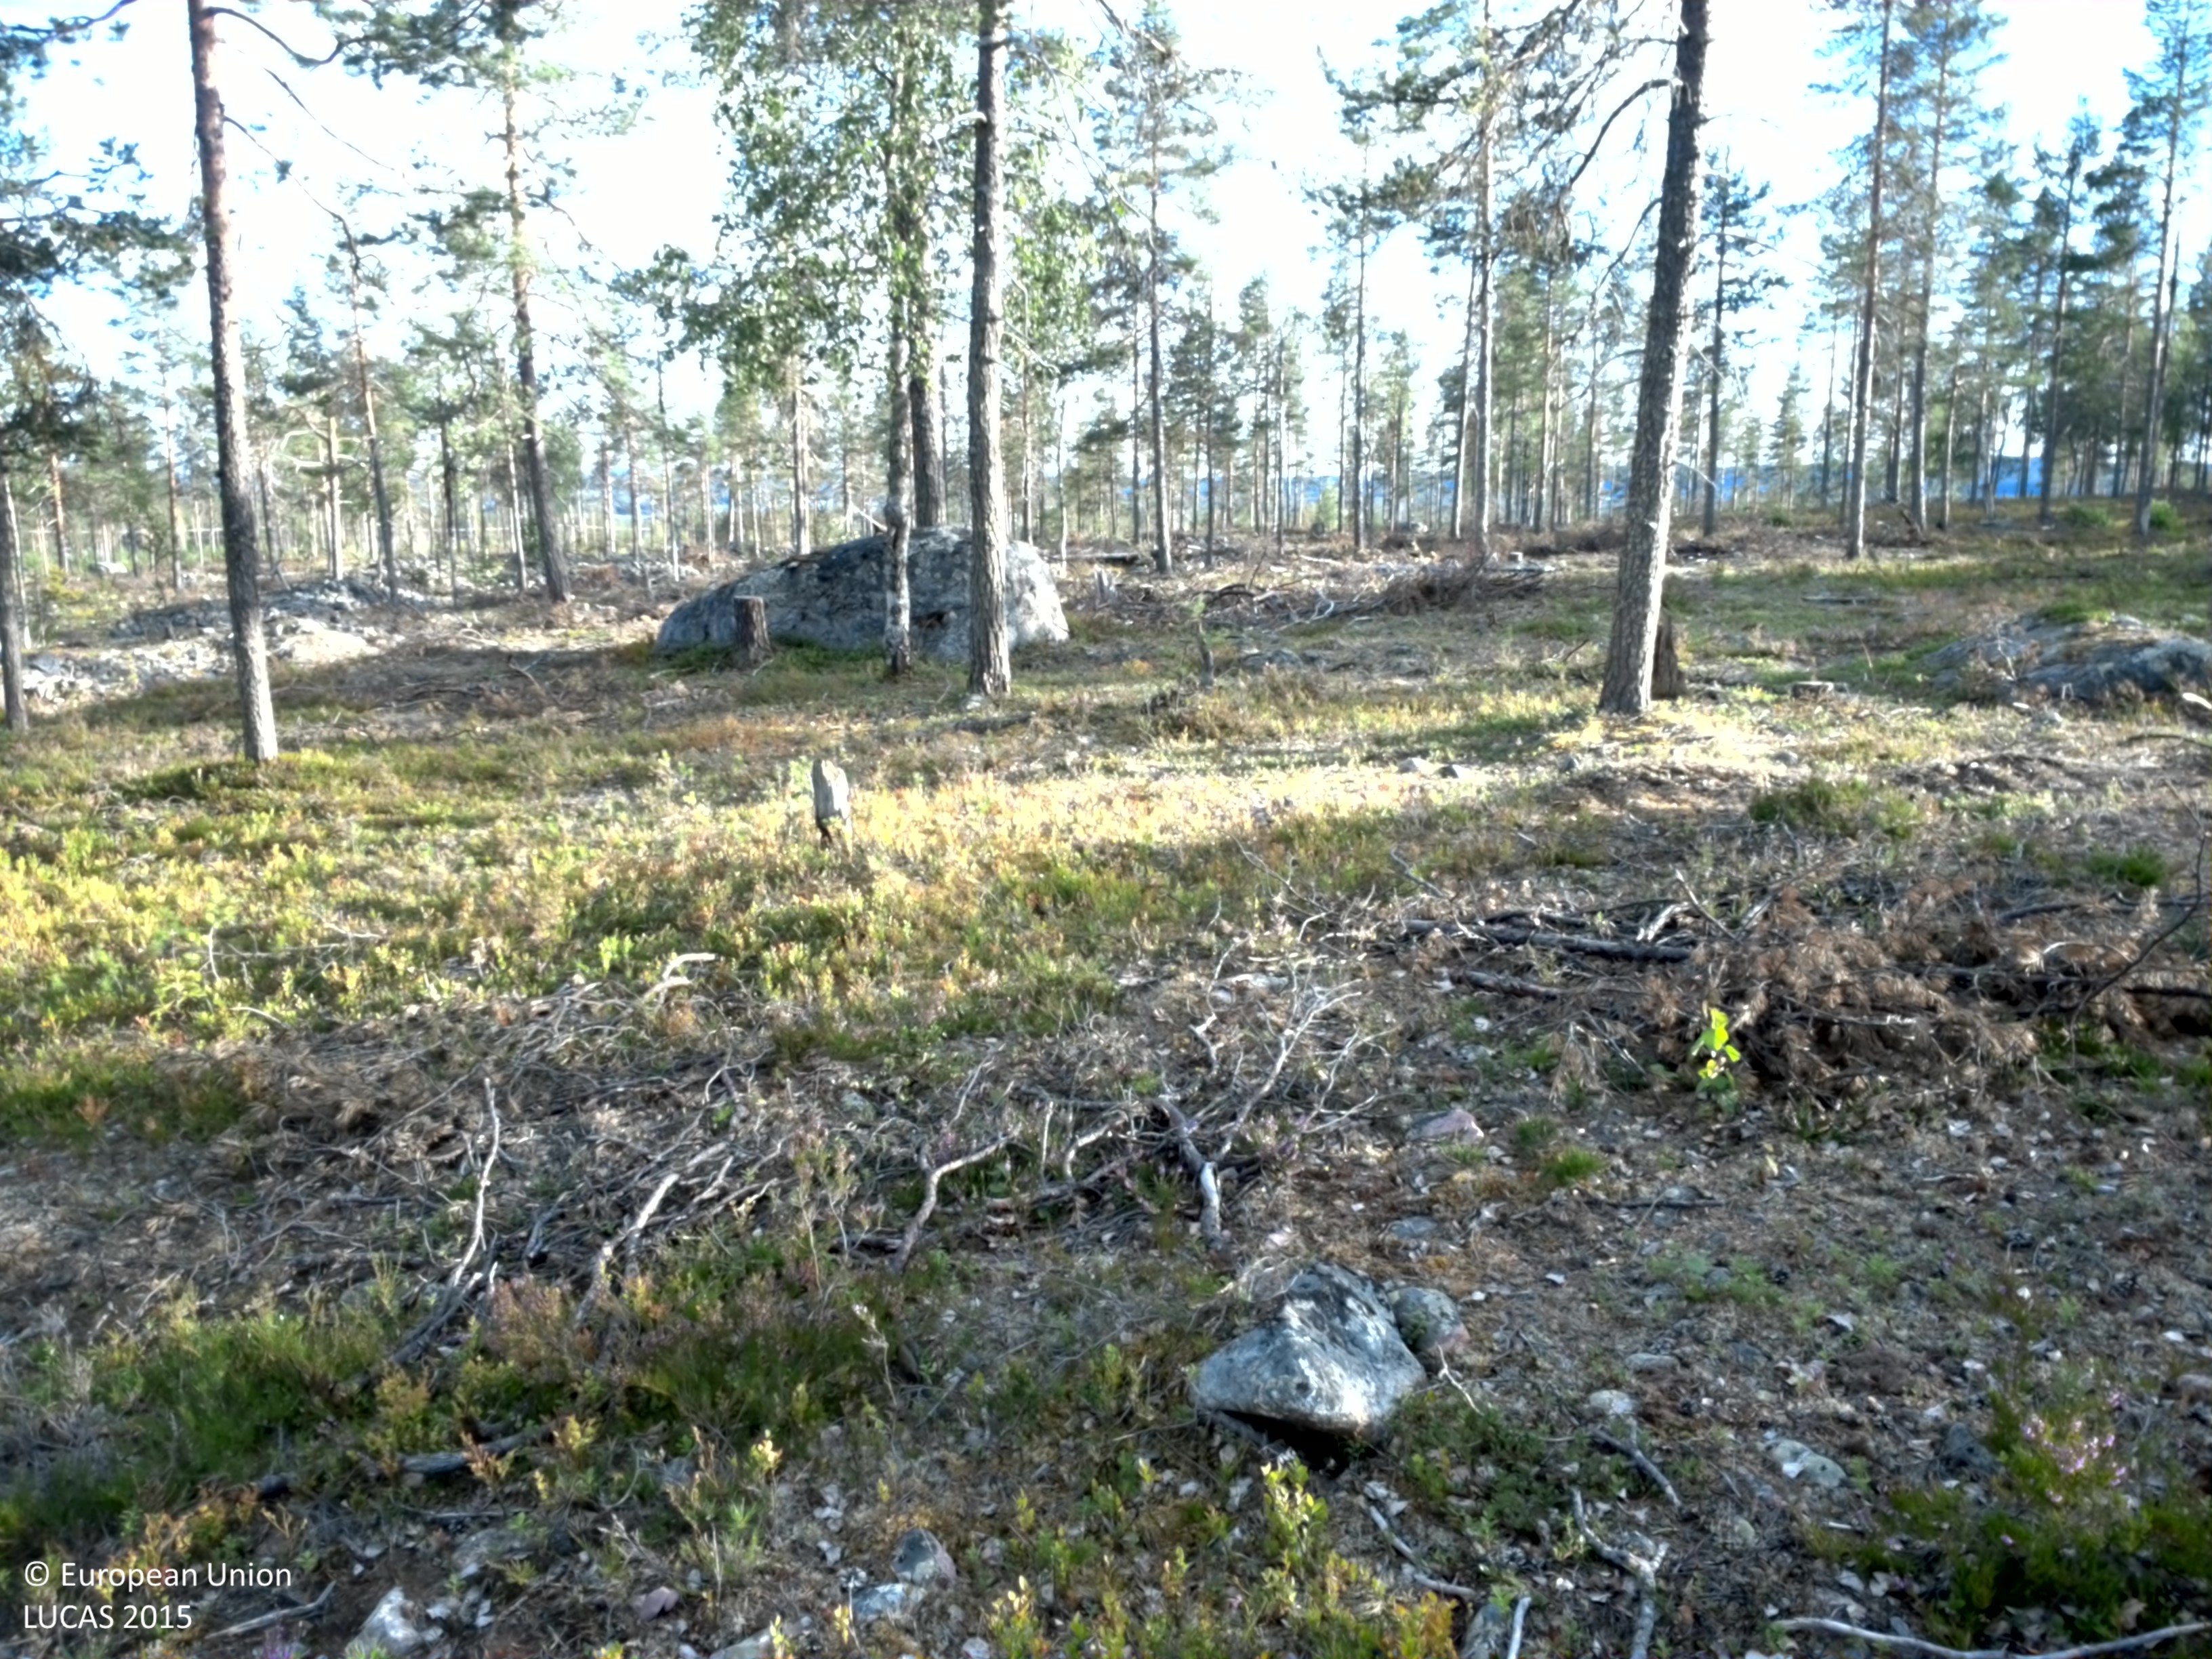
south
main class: Woodland
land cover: Pine dominated coniferous woodland
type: boreal forest
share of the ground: 10 - 25 %
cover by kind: shrubs 40 %, consolidated bare surface 25 %, lichens and mosses 20 %, coniferous forest trees 15 %
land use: Forestry
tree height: > 5 m
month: August
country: SE
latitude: 66.1569
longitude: 22.7711
